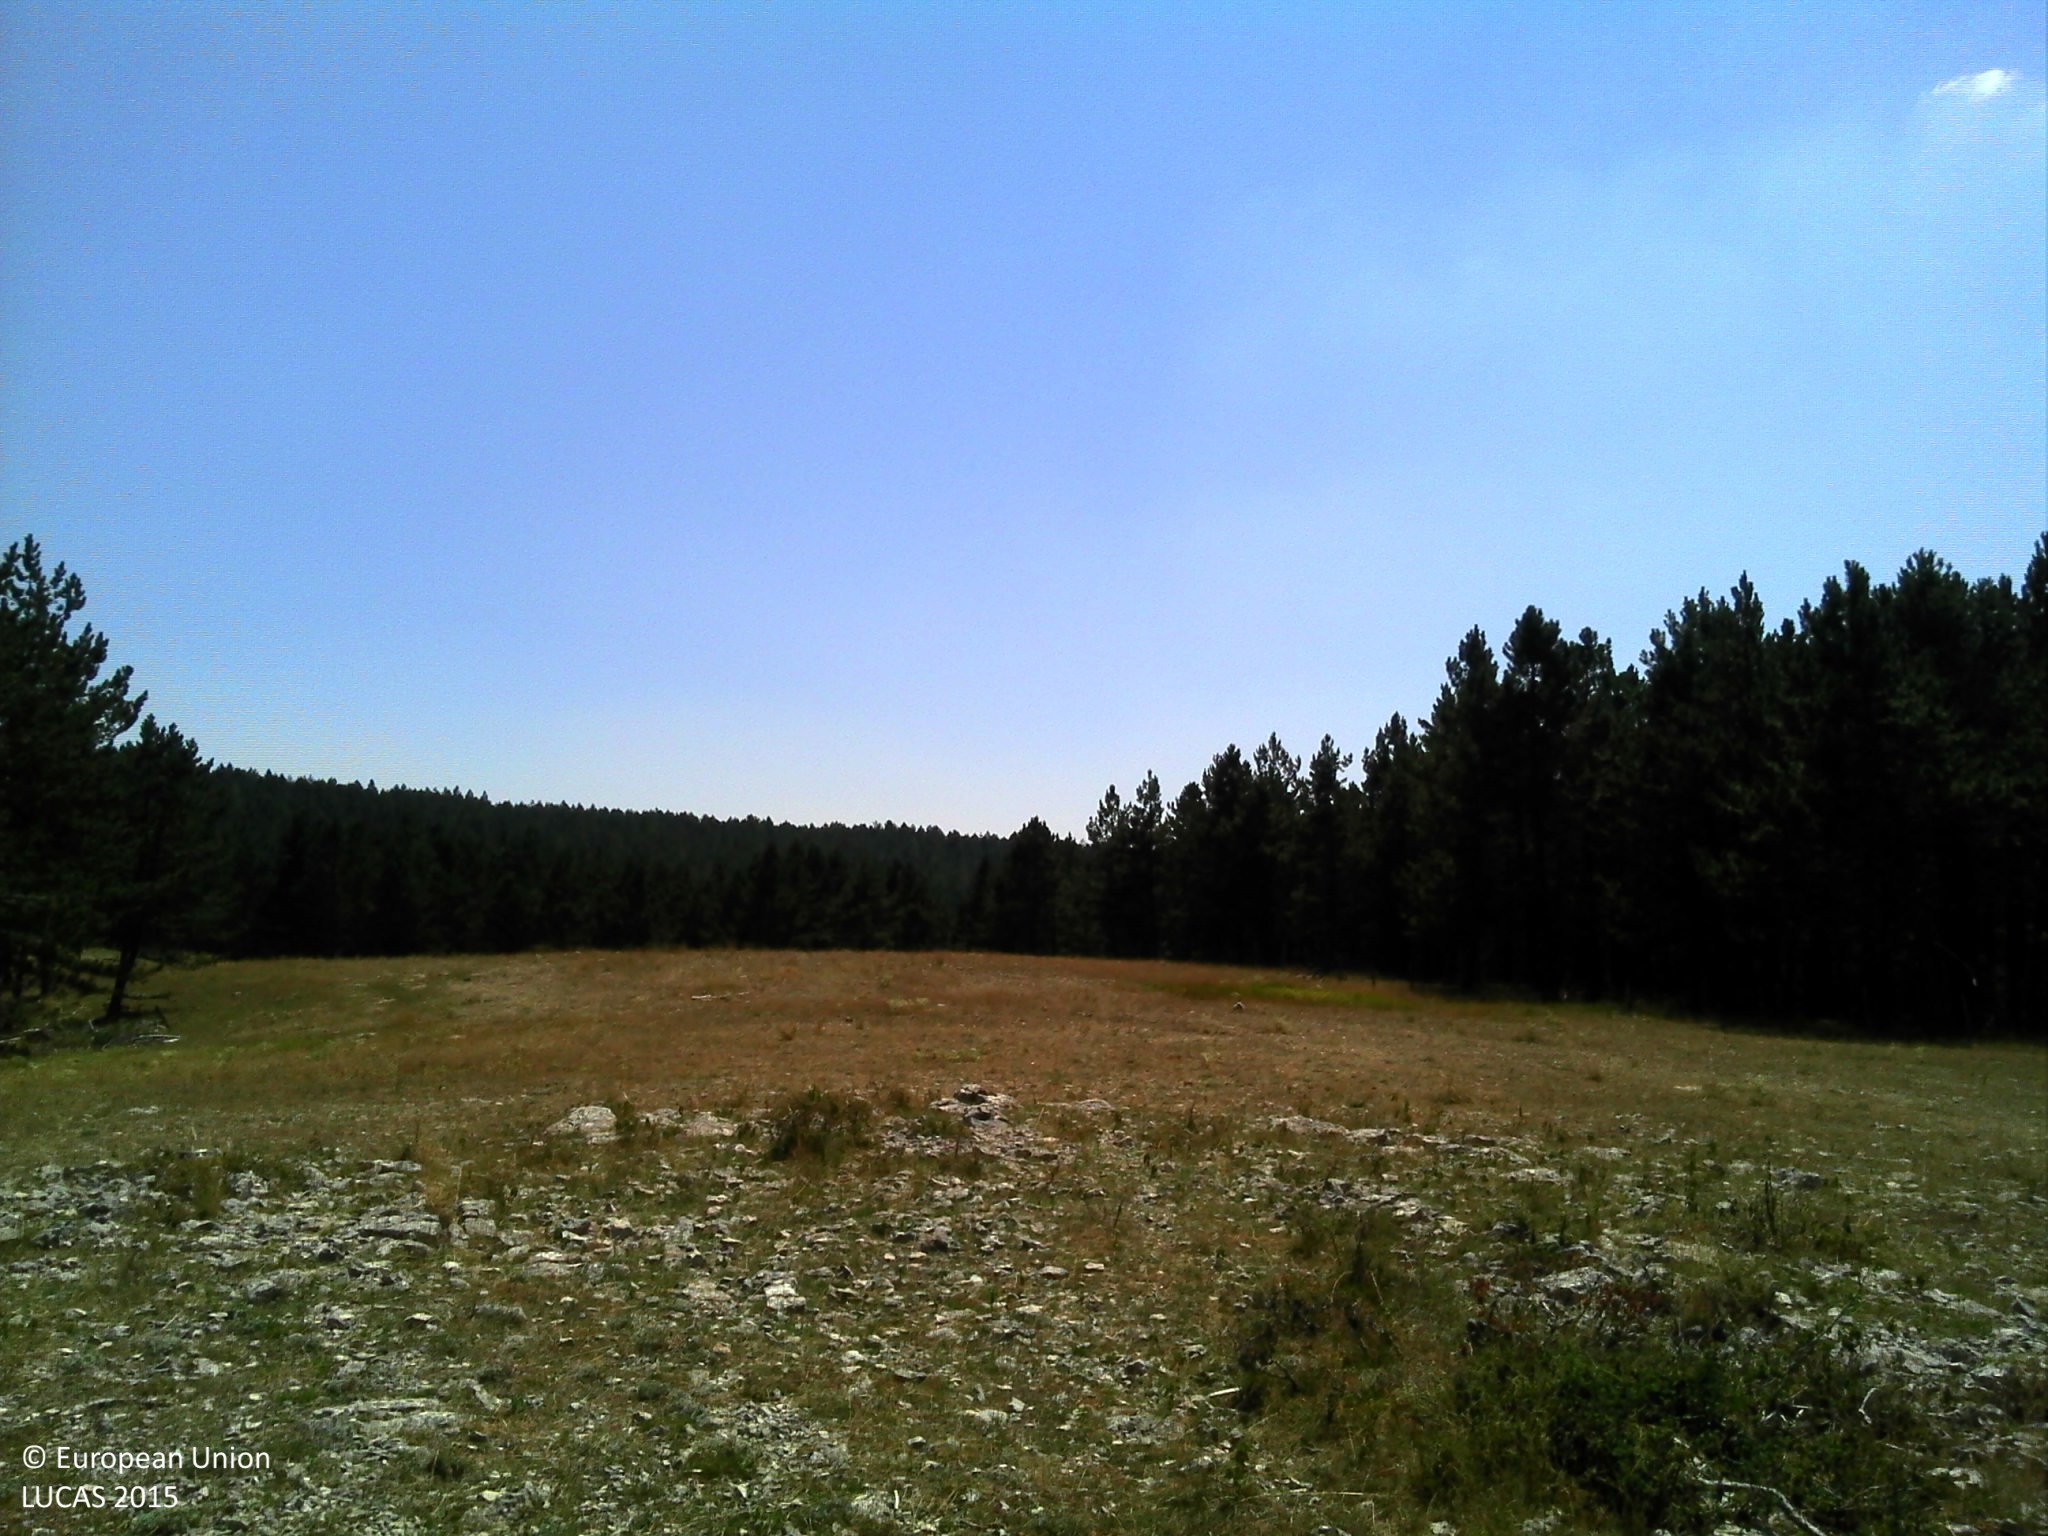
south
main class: Grassland
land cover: Grassland without tree/shrub cover
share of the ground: > 75 %
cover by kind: herbaceous plants 85 %, consolidated bare surface 10 %, shrubs 5 %
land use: Agriculture (excluding fallow land and kitchen gardens)
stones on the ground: > 50 %
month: August
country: FR
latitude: 44.2361
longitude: 3.4830
